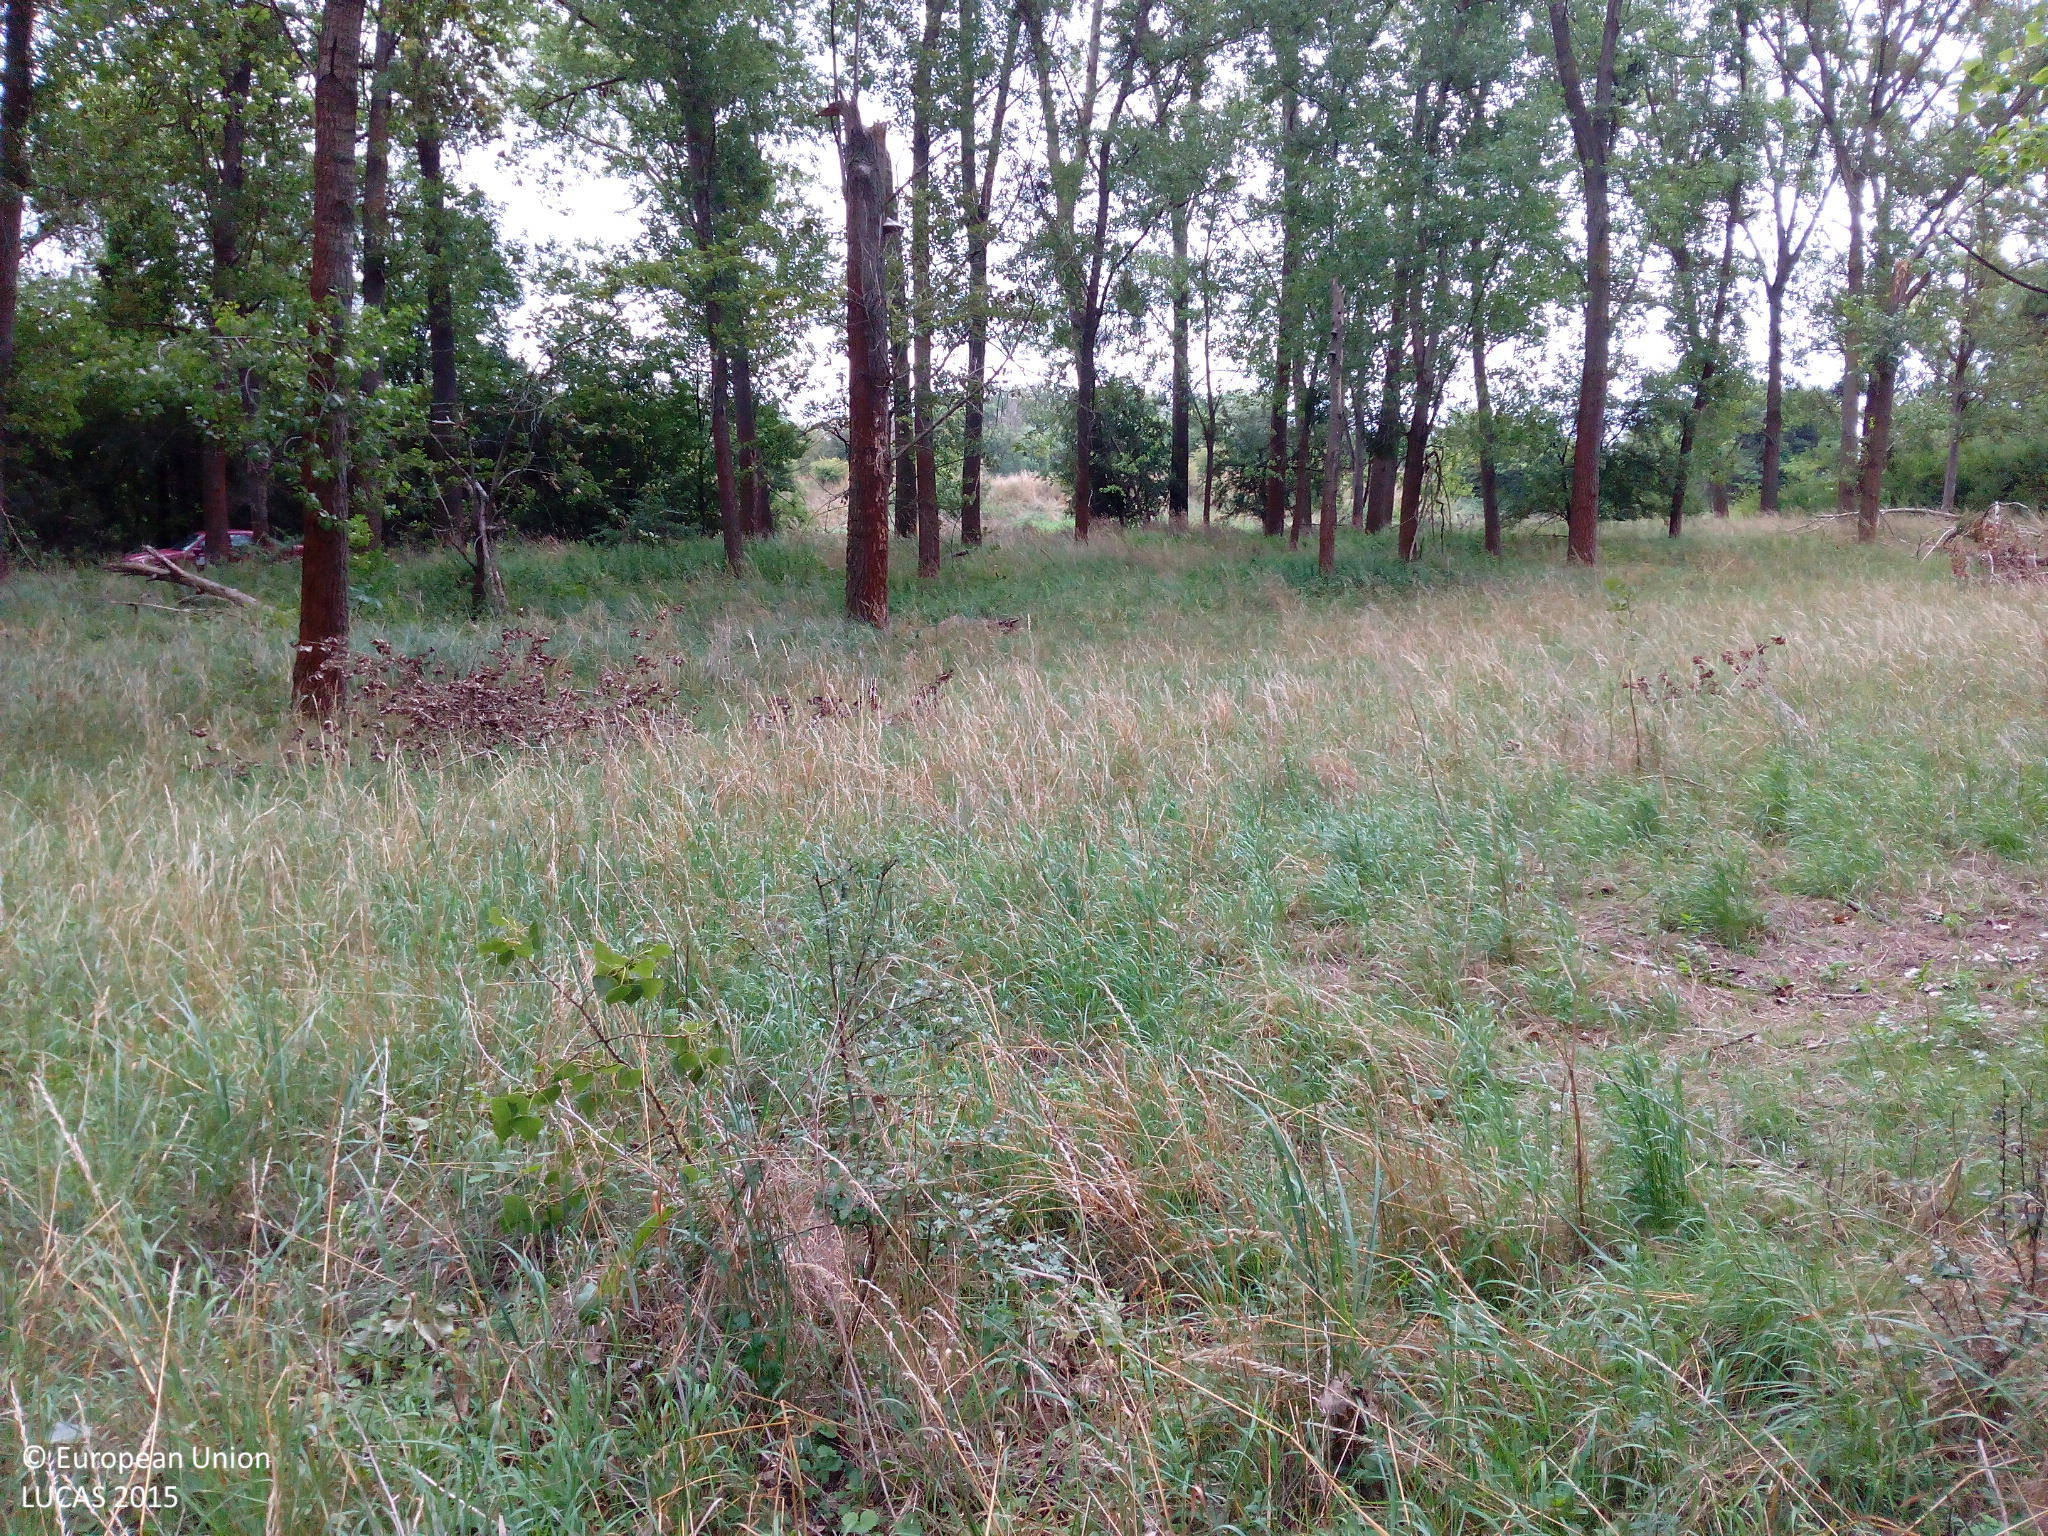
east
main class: Woodland
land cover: Broadleaved woodland
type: mesophytic deciduous forest
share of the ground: > 75 %
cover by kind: broadleaved forest trees 75 %, herbaceous plants 25 %
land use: Forestry
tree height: > 5 m
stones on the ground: < 10 %
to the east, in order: Broadleaved woodland; Tracks; Broadleaved woodland; Grassland without tree/shrub cover; Tracks; Abandoned hedges; Common wheat; Shrubland with sparse tree cover; Broadleaved woodland; Inland fresh running water; Broadleaved woodland
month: July
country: DE
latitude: 52.7375
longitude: 14.1331
